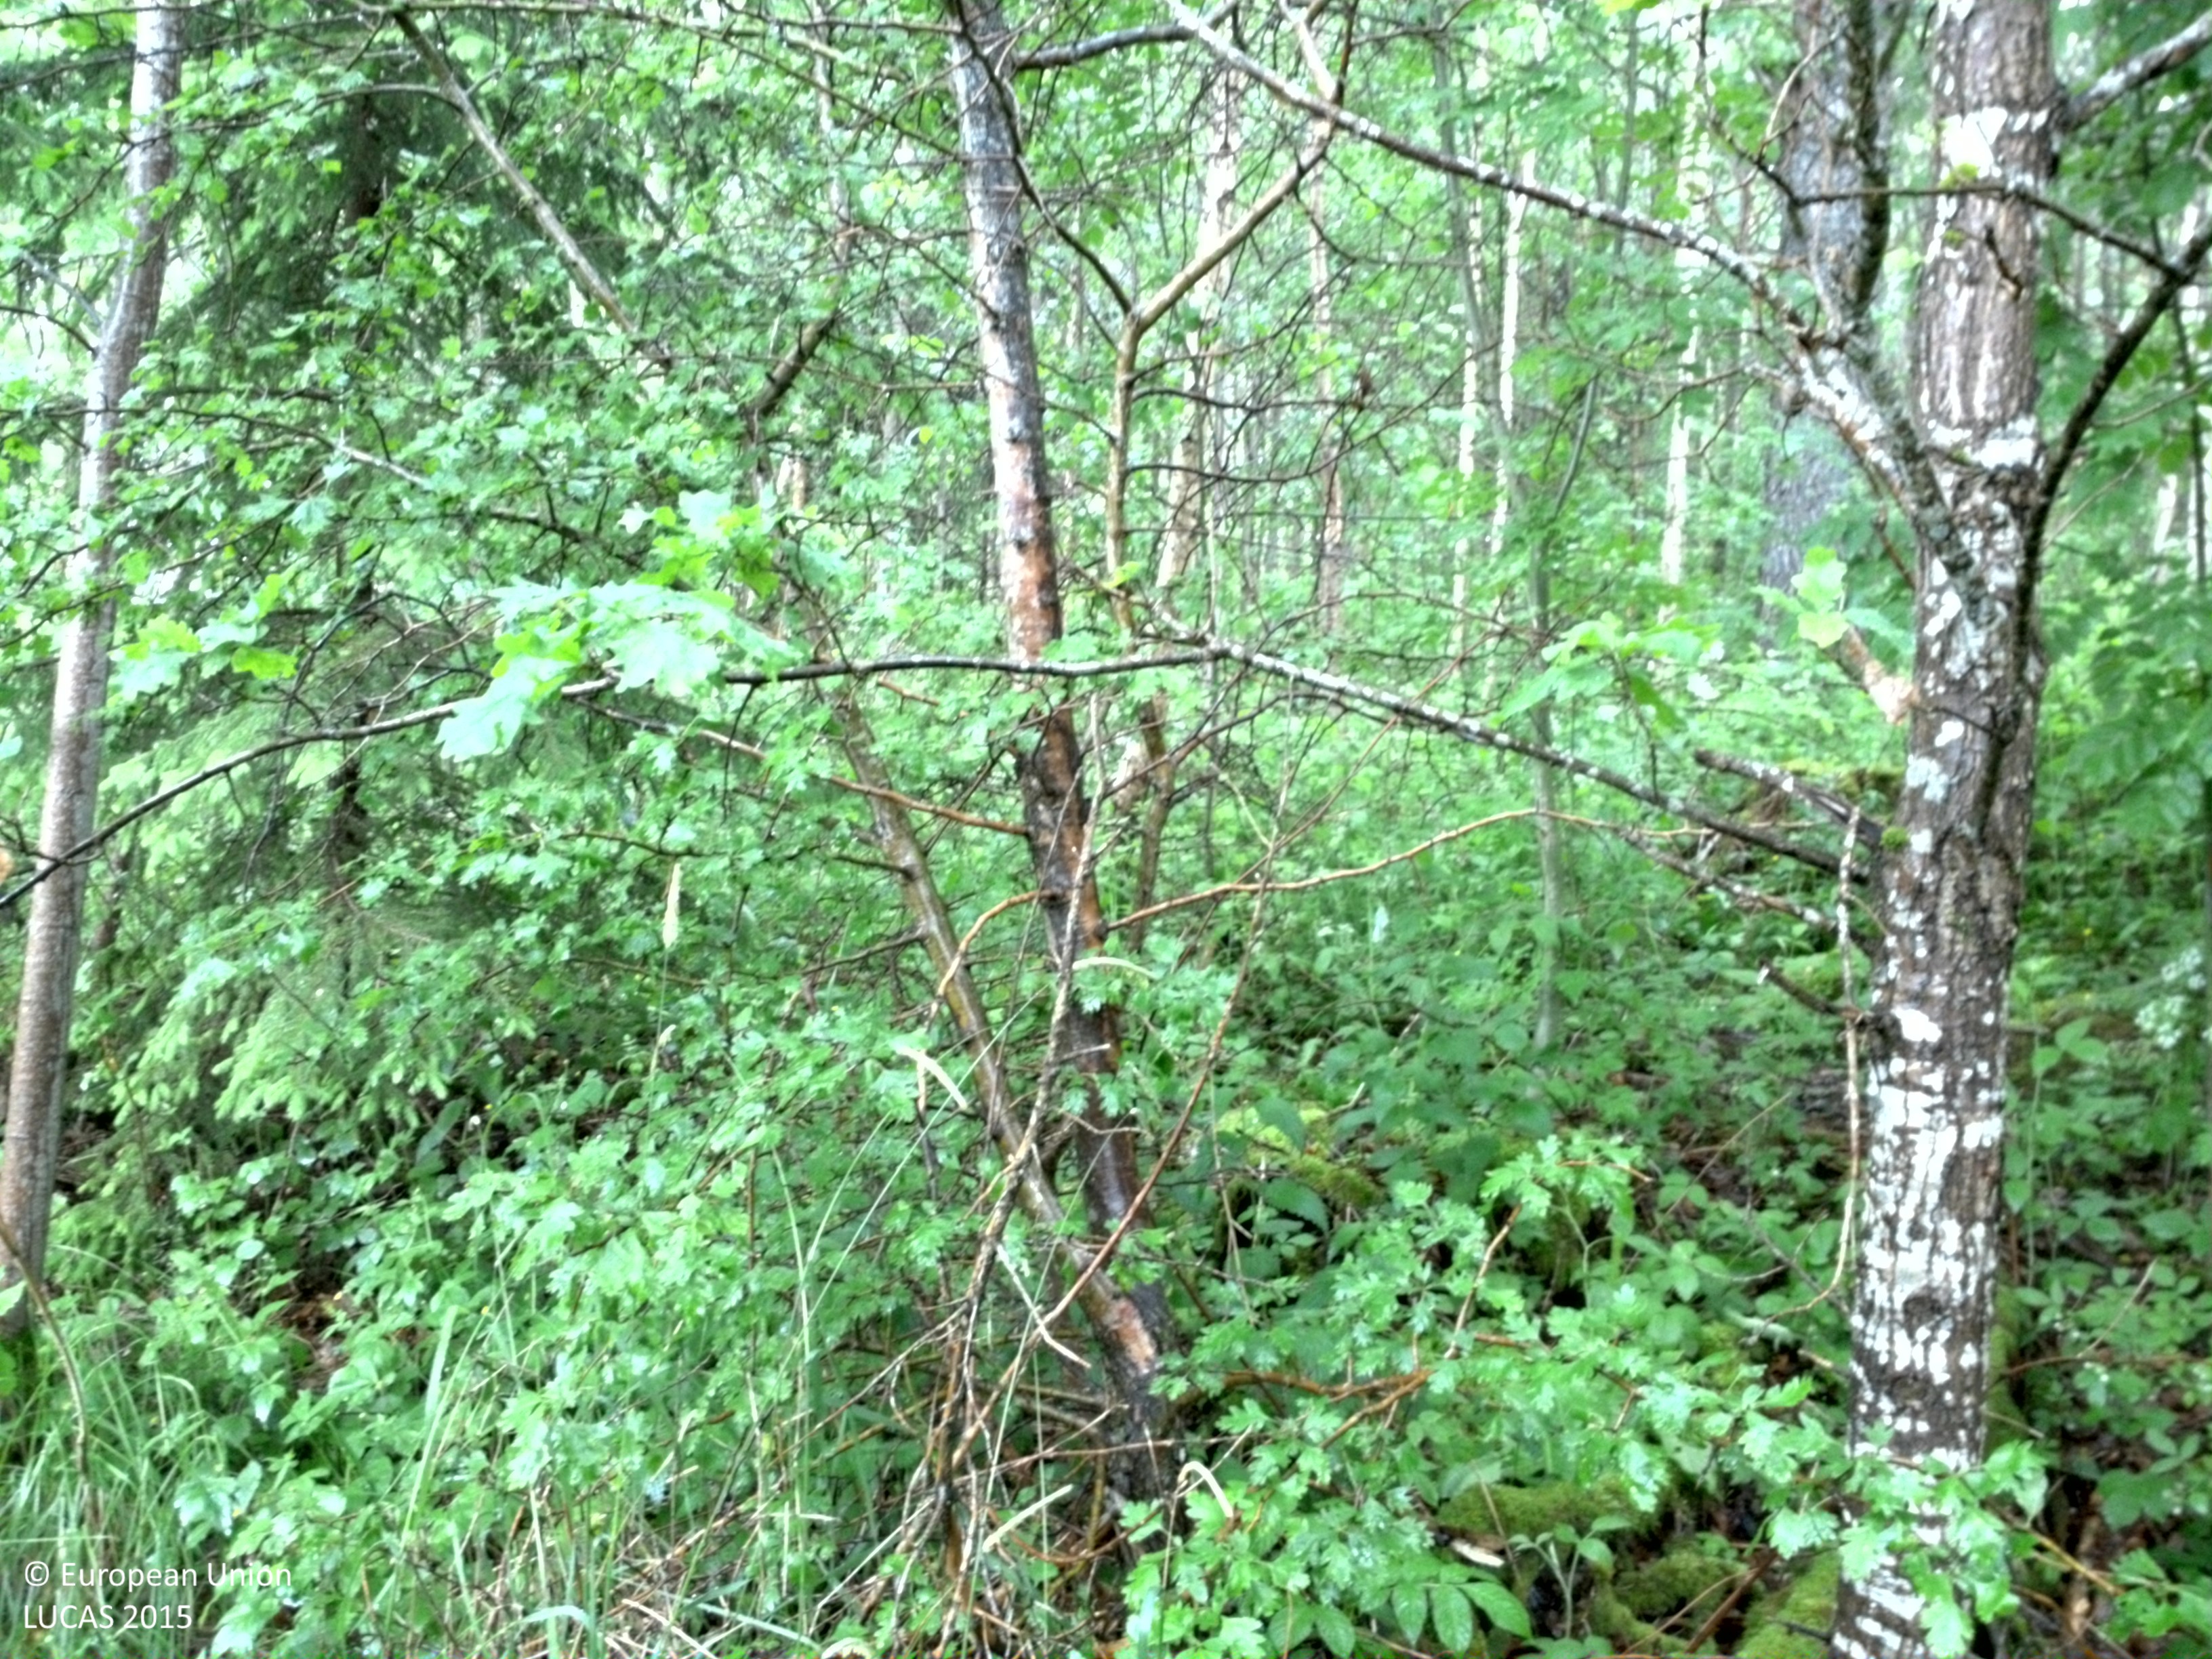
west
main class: Woodland
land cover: Broadleaved woodland
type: acidophilous oak and oak-birch forest
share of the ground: > 75 %
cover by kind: broadleaved forest trees 85 %, herbaceous plants 15 %
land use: Forestry
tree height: > 5 m
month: June
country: SE
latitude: 58.7243
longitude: 15.3987
